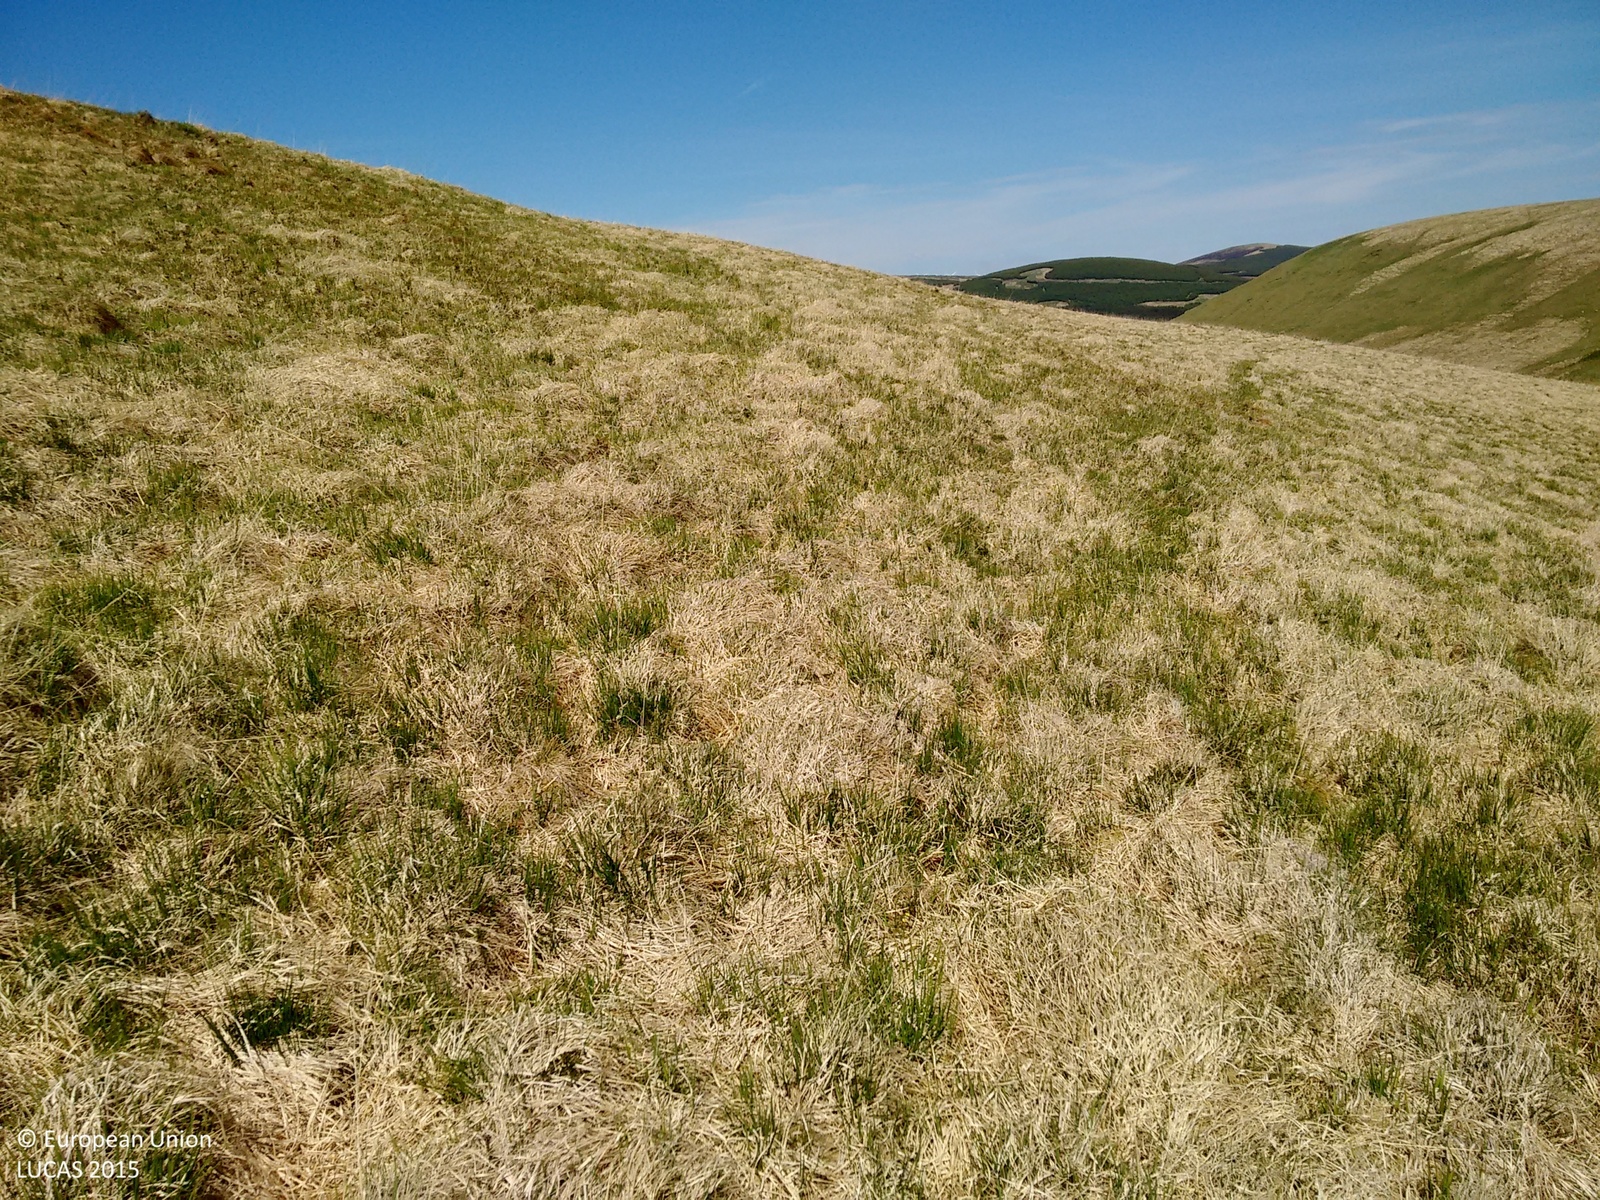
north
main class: Grassland
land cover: Grassland without tree/shrub cover
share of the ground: > 75 %
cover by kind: herbaceous plants 100 %
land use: Semi-natural and natural areas not in use
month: June
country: GB
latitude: 55.4723
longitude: -3.4779
